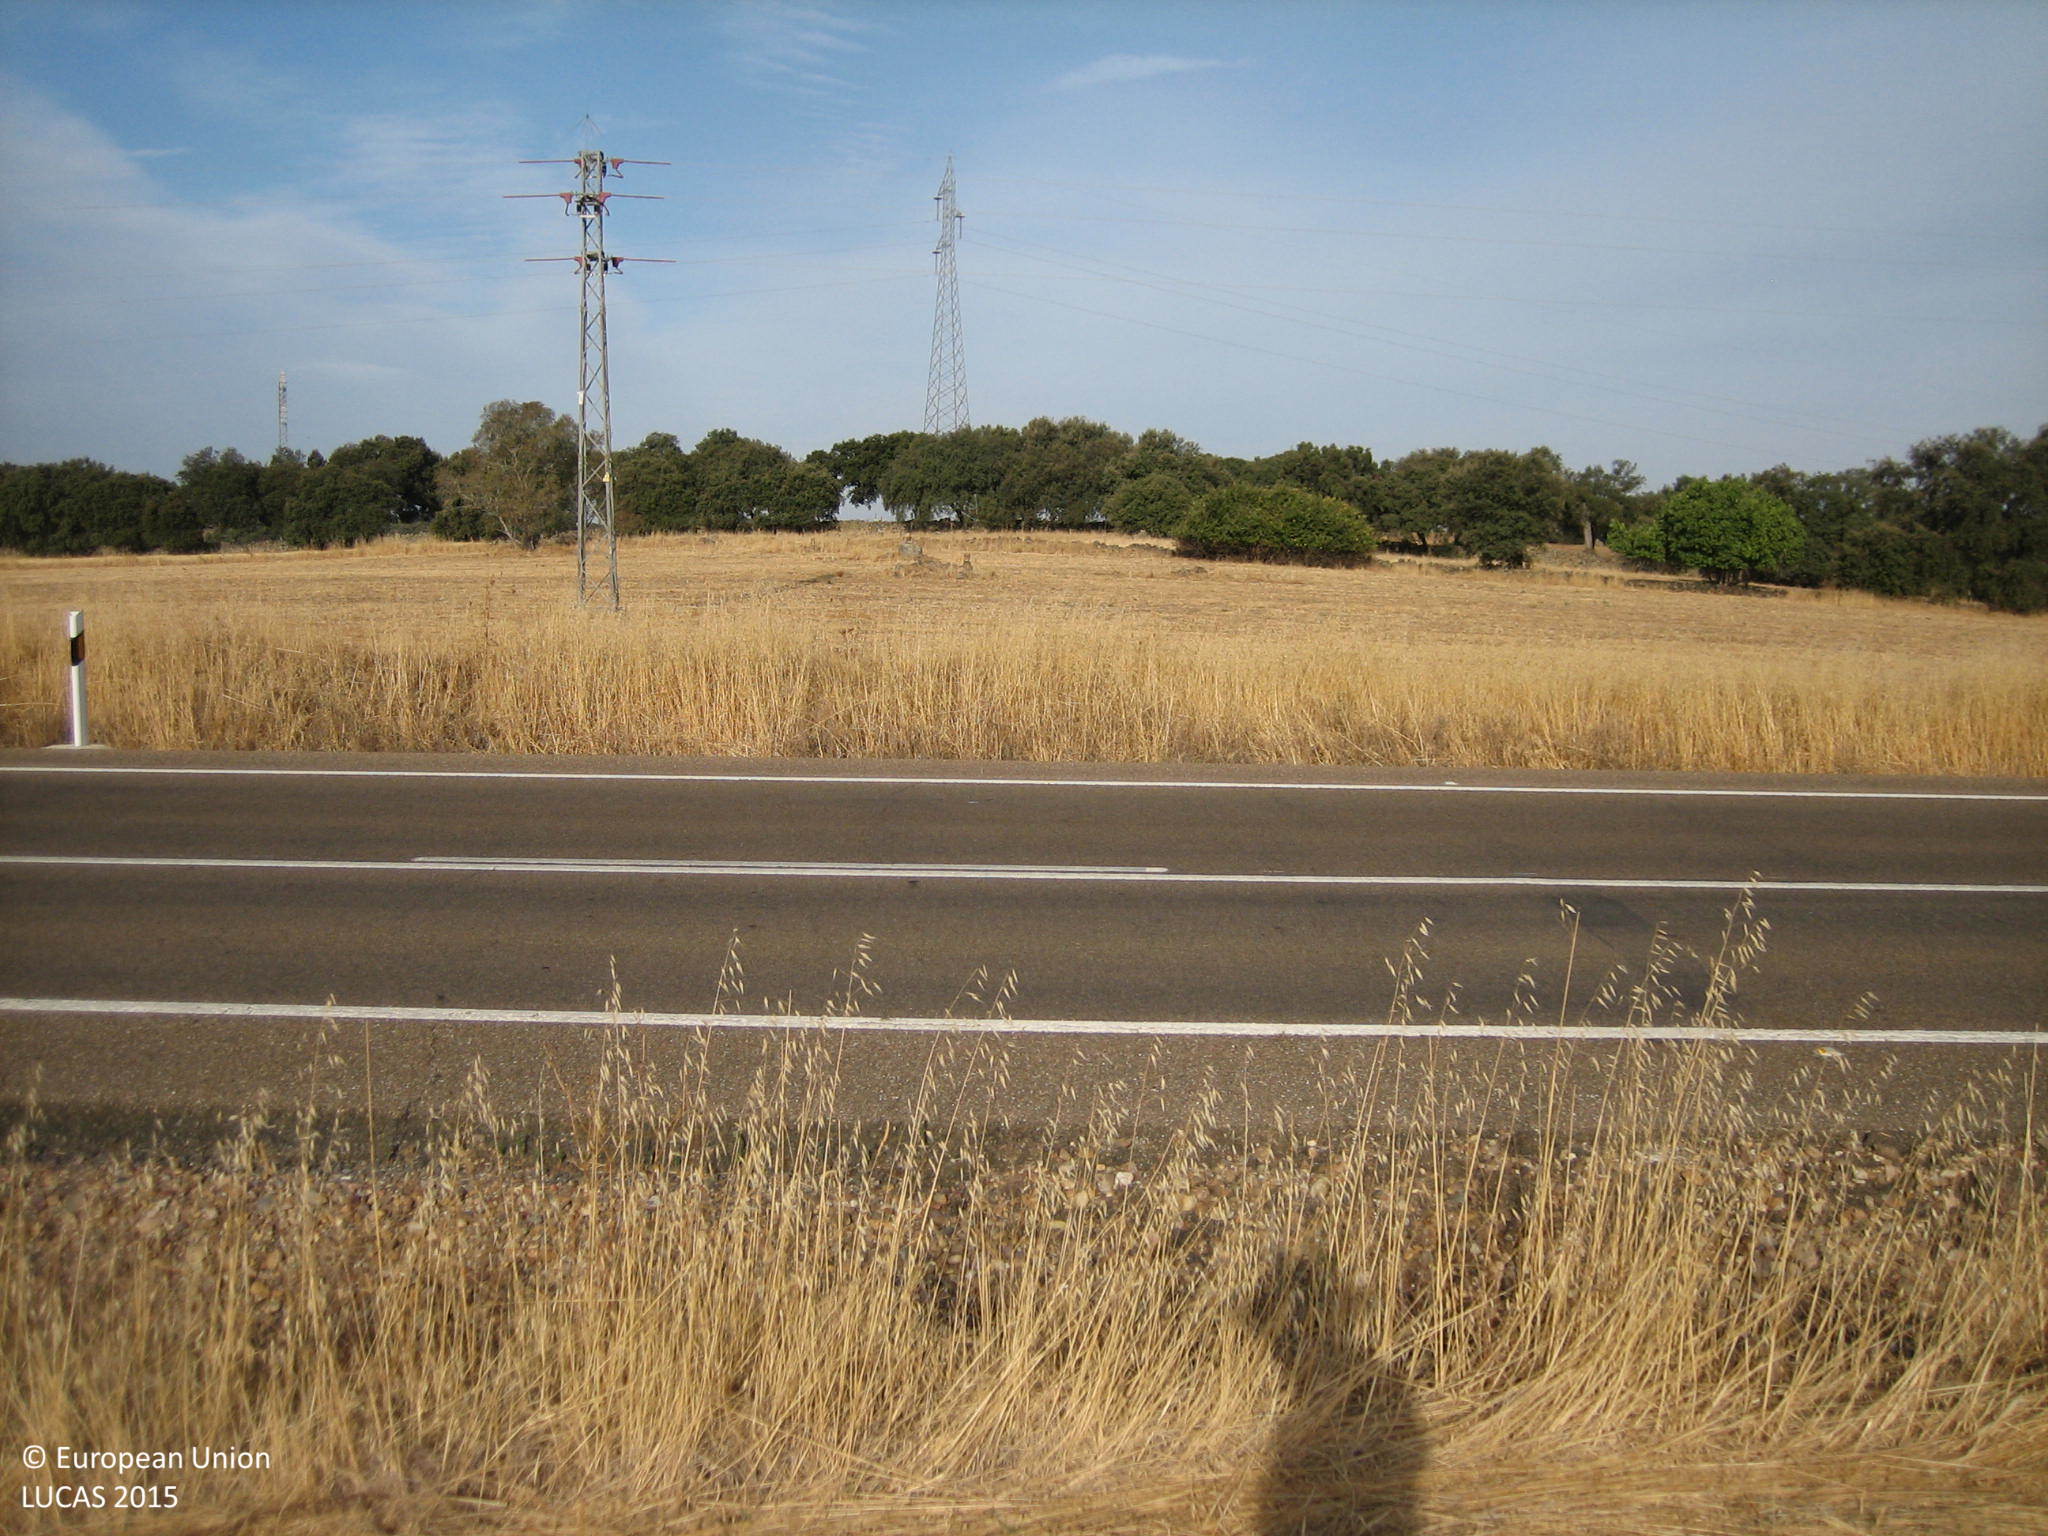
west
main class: Grassland
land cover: Grassland without tree/shrub cover
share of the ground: > 75 %
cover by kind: herbaceous plants 100 %
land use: Semi-natural and natural areas not in use
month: September
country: ES
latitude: 38.4837
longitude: -6.8546
